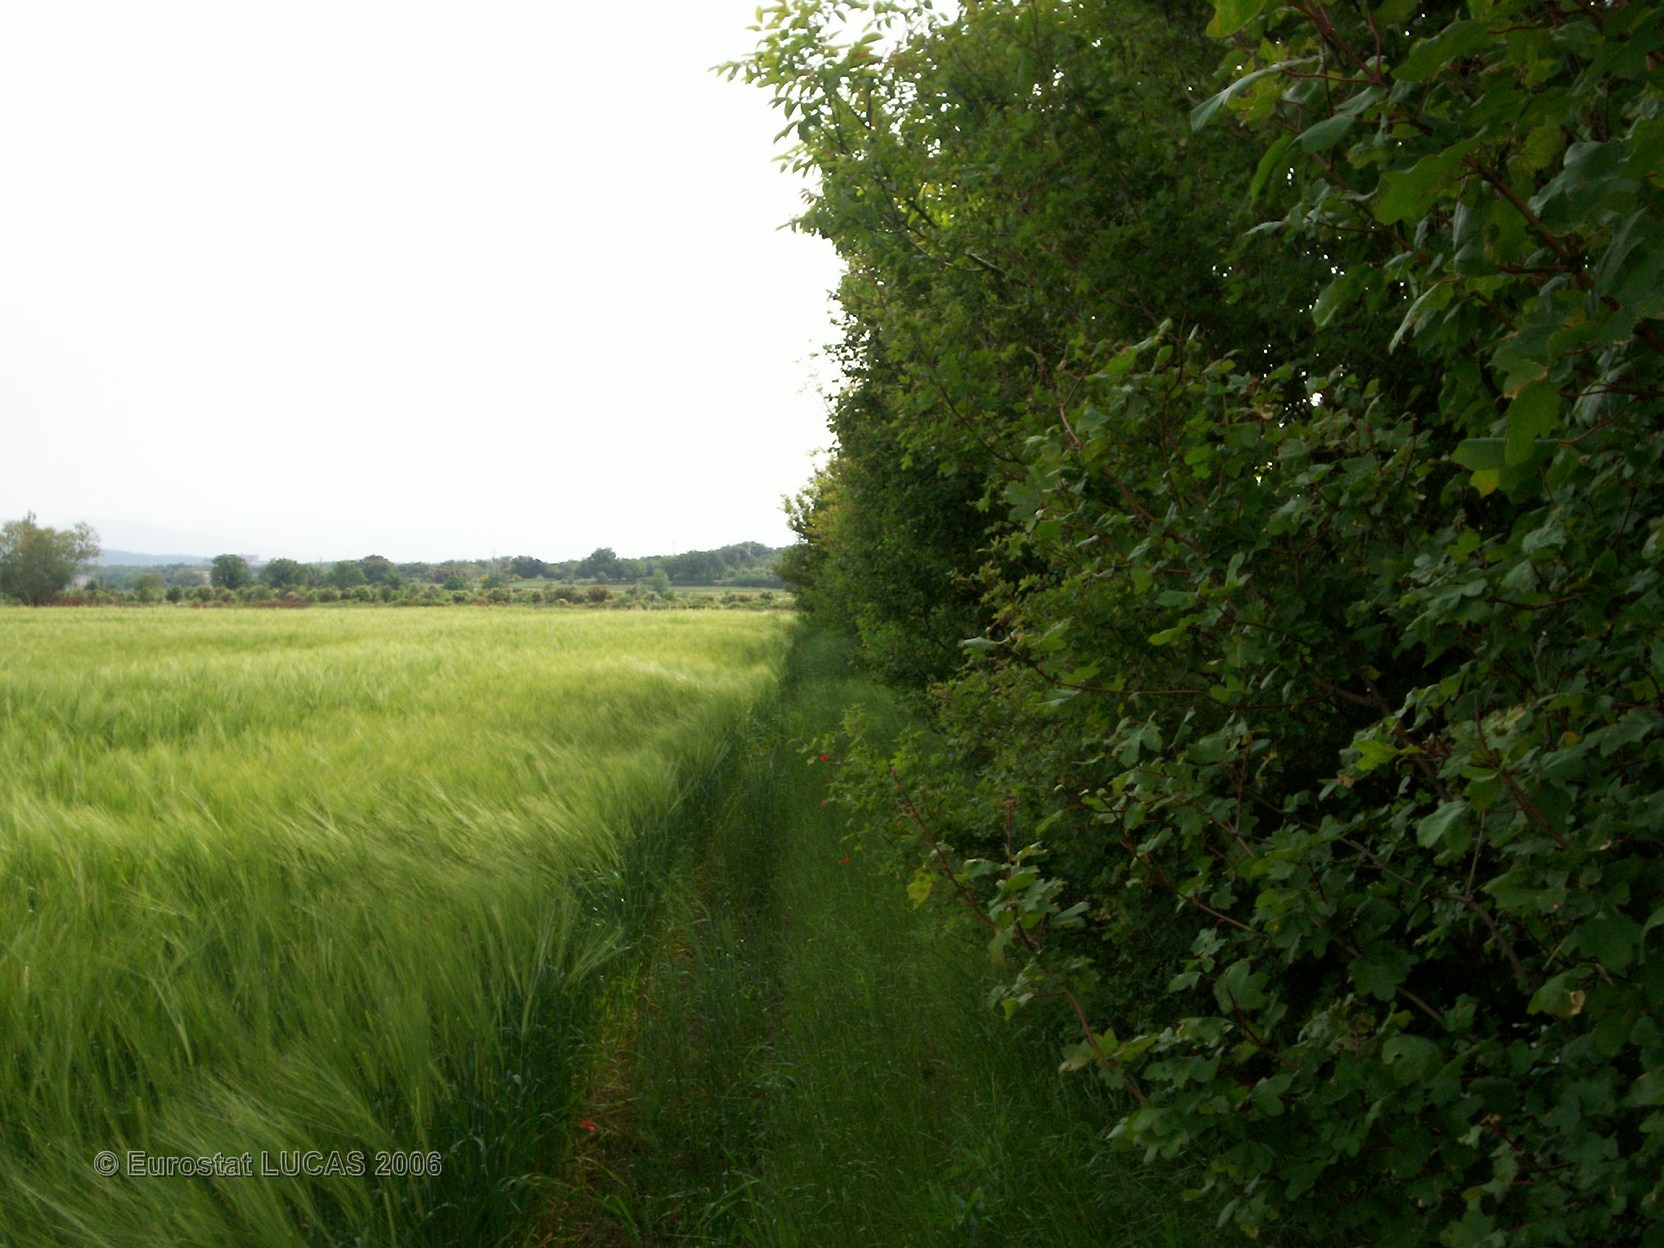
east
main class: Cropland
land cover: Barley
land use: Agriculture (excluding fallow land and kitchen gardens)
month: May
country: FR
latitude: 44.4045
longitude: 4.8716
